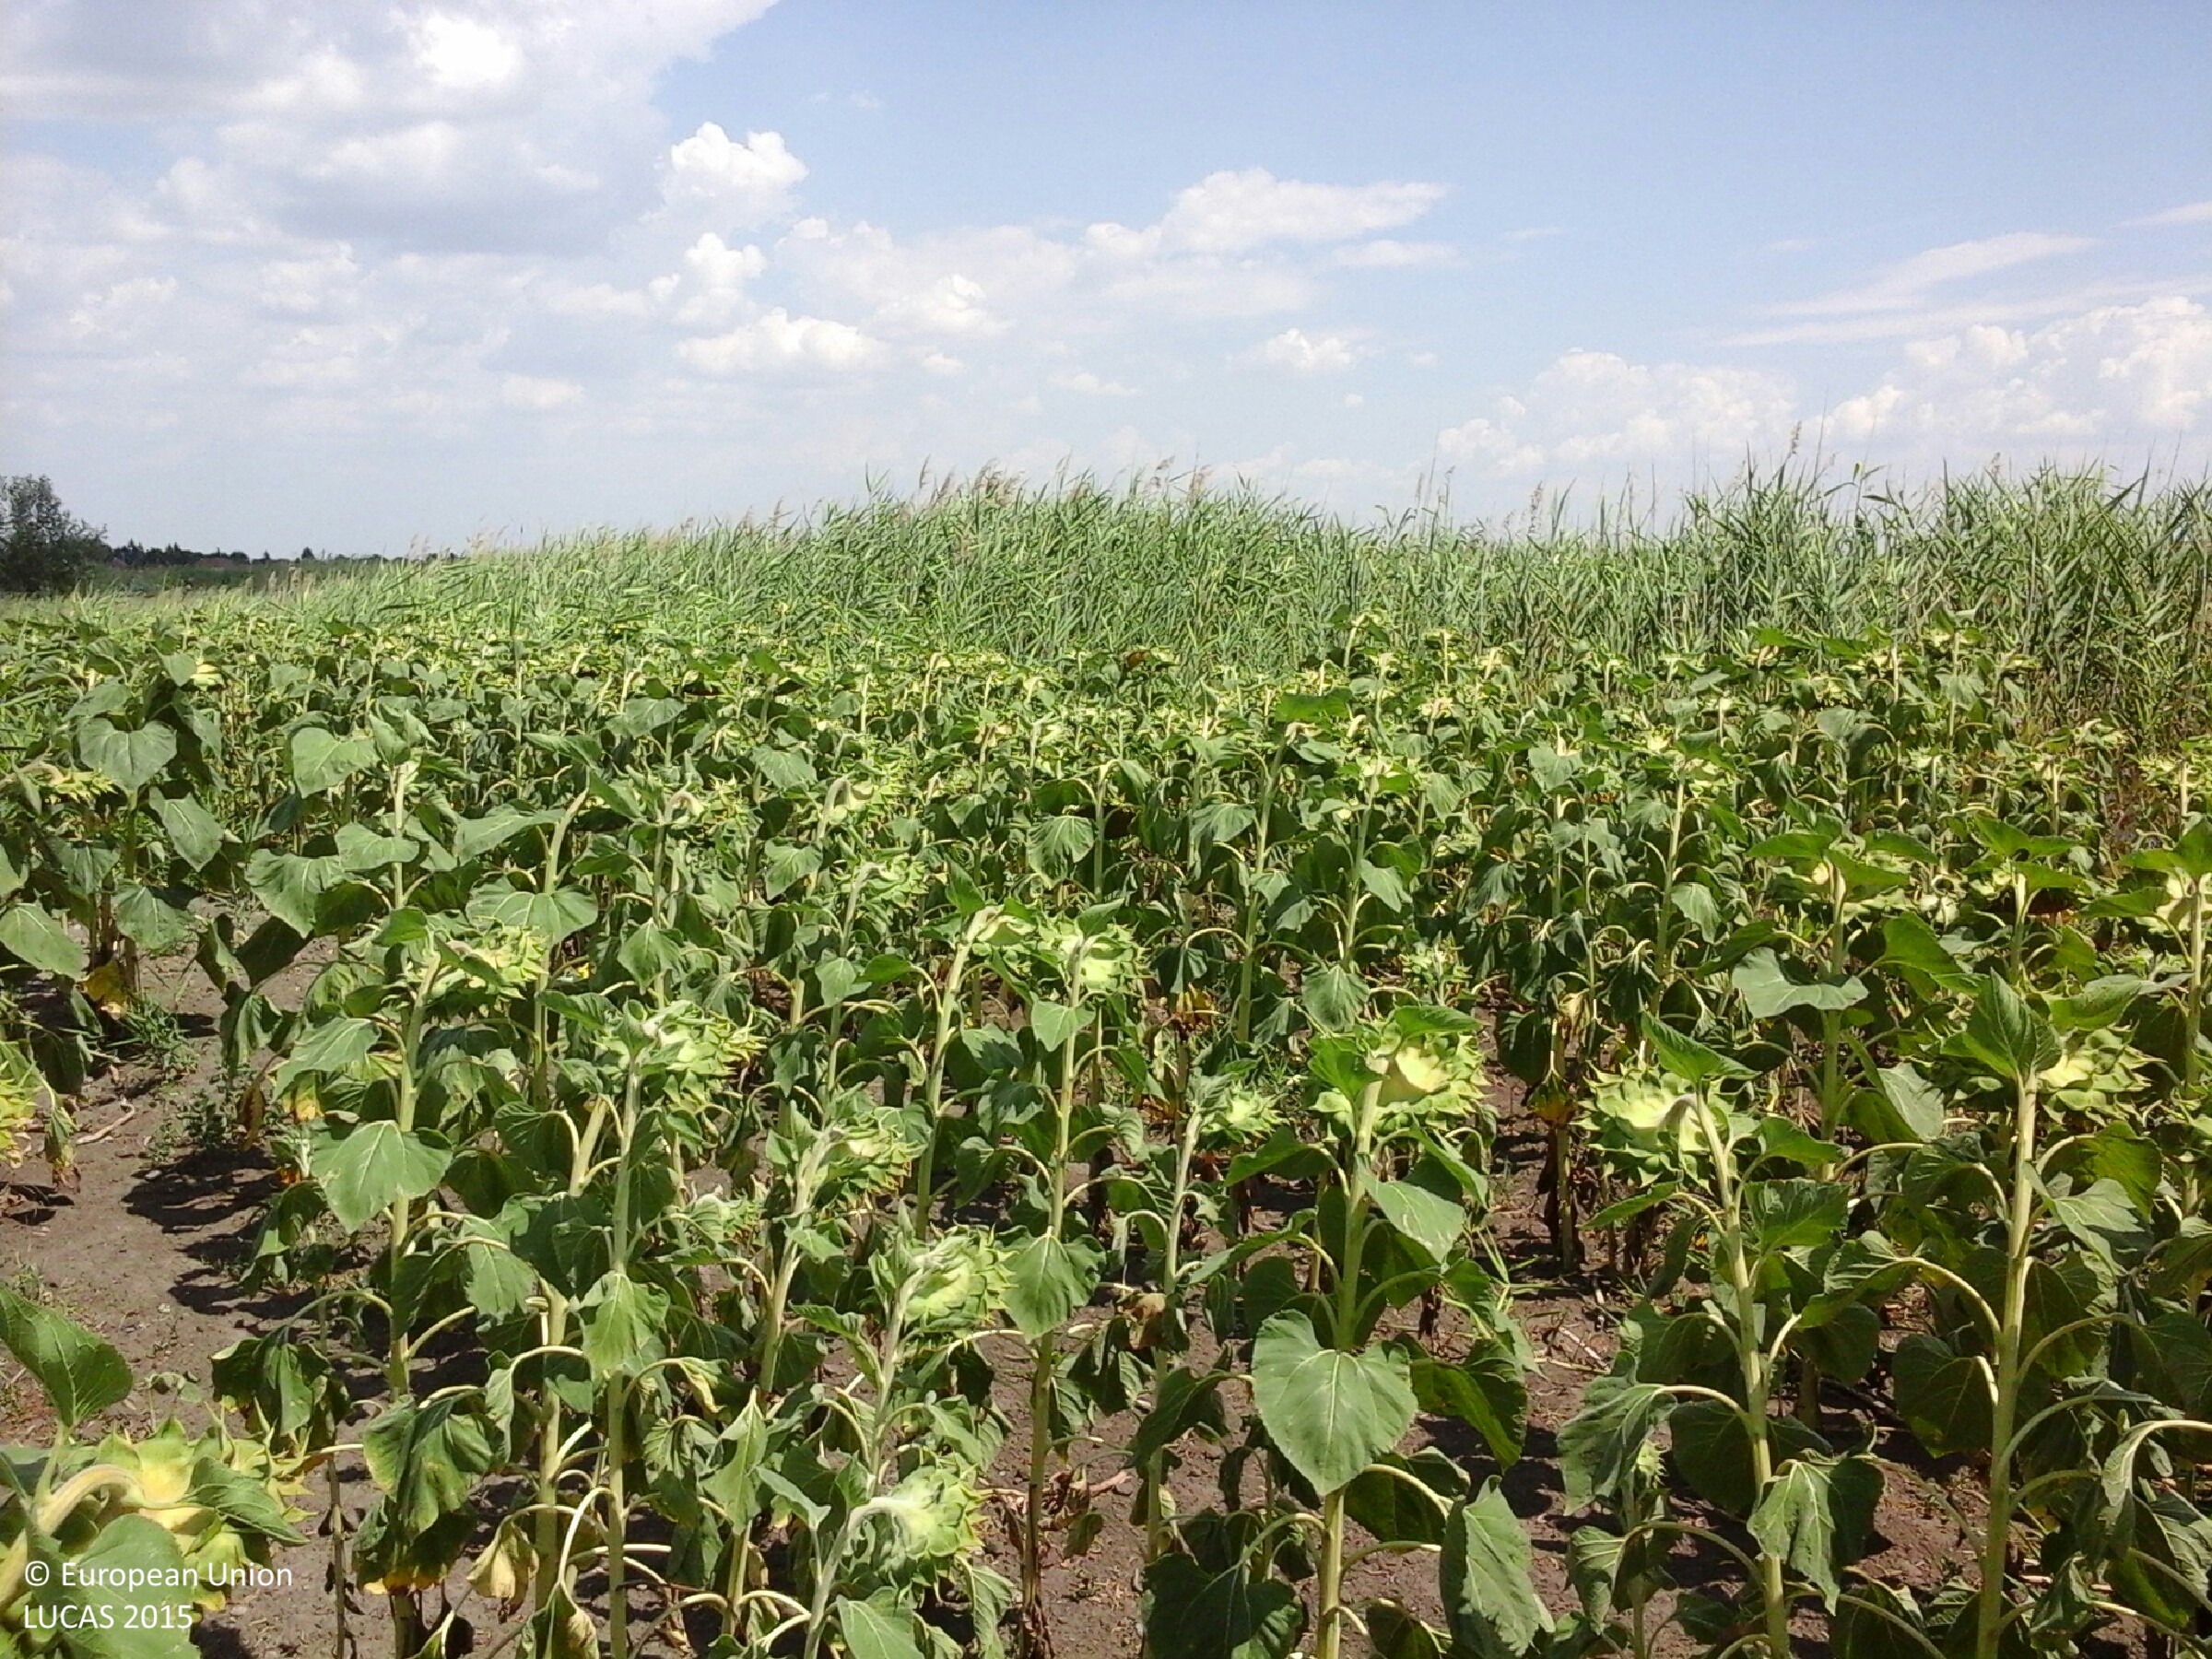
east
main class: Cropland
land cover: Sunflower
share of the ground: > 75 %
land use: Agriculture (excluding fallow land and kitchen gardens)
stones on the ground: < 10 %
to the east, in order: Sunflower; Ditches and canals; Grass margins; Tracks; Grass margins; Ditches and canals; Maize; Common wheat; Sunflower
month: July
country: HU
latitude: 47.7108
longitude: 20.6025
